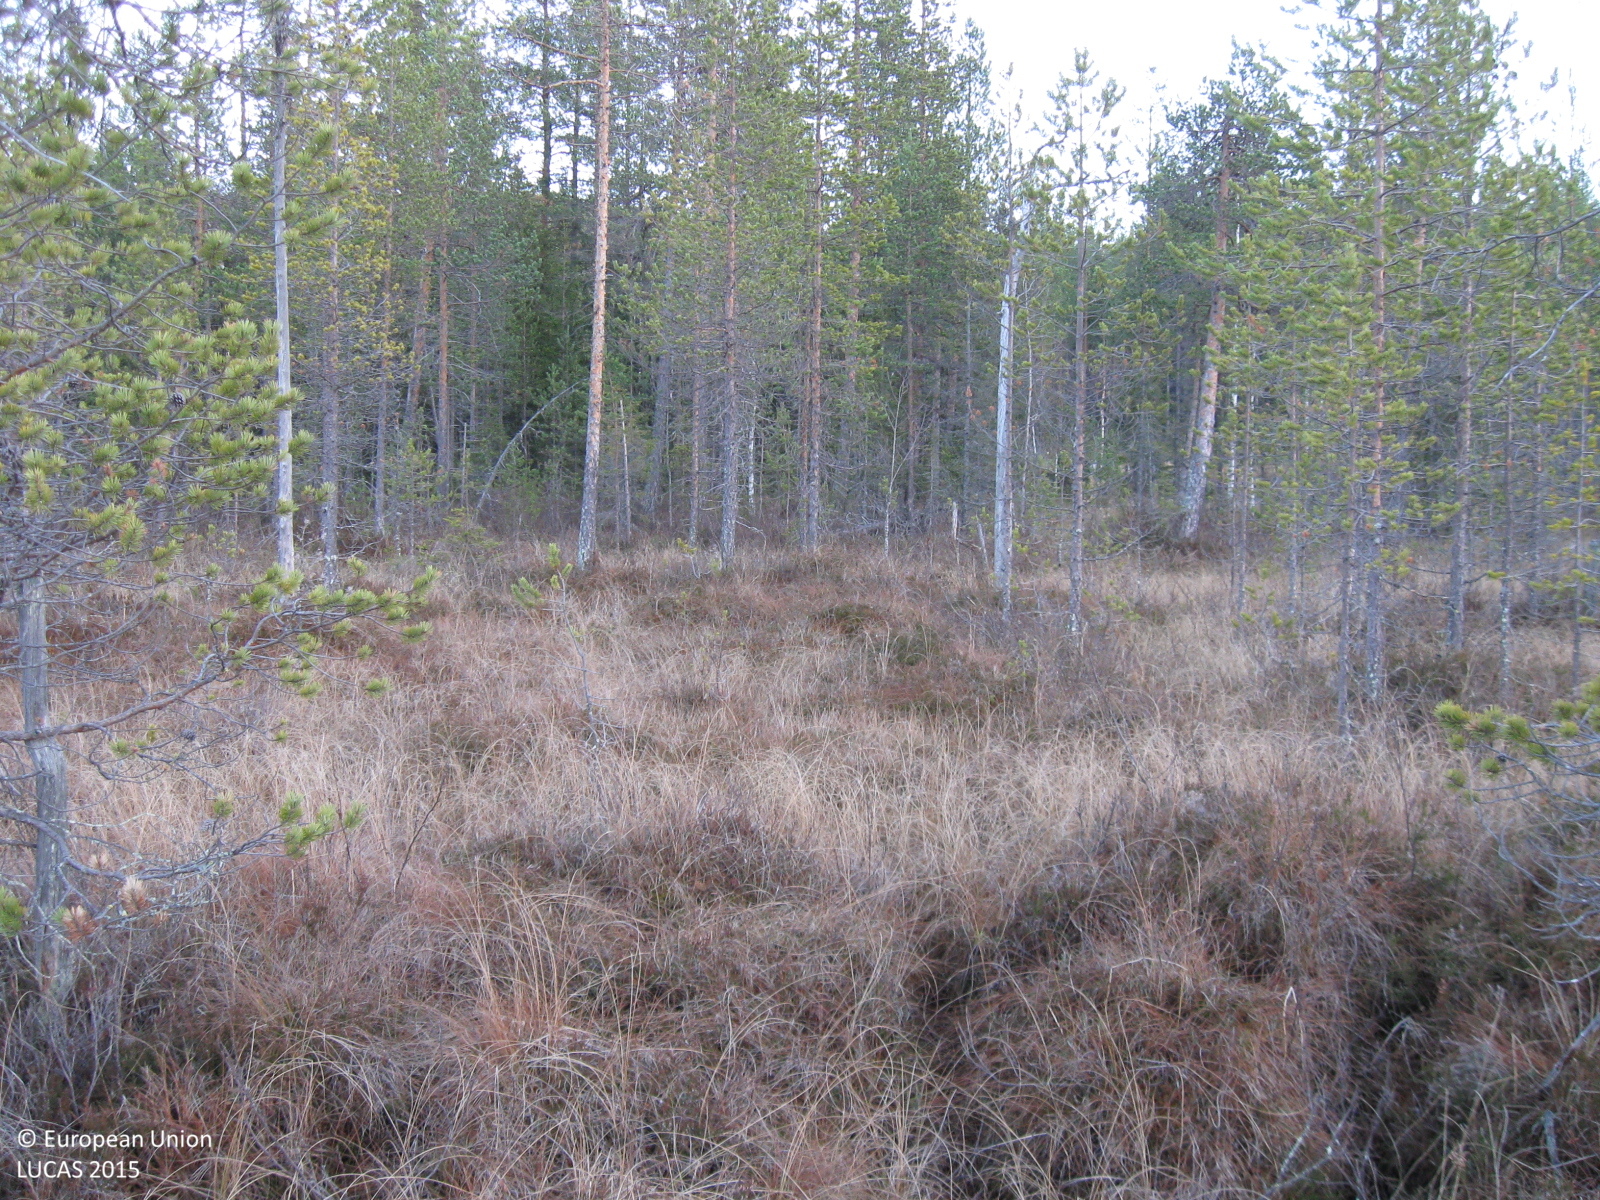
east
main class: Woodland
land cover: Pine dominated coniferous woodland
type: mire and swamp forests
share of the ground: 25 - 50 %
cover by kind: herbaceous plants 60 %, coniferous forest trees 25 %, shrubs 10 %, lichens and mosses 5 %
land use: Semi-natural and natural areas not in use
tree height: < 5 m
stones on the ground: < 10 %
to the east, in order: Pine dominated coniferous woodland; Spruce dominated mixed woodland; Shruby margins; Paved roads, cycling and walking lanes; Shruby margins; Ditches and canals; Pine dominated mixed woodland; Other mixed woodland; Pine dominated coniferous woodland; Pine dominated mixed woodland
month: November
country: SE
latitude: 66.1779
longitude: 20.6329
